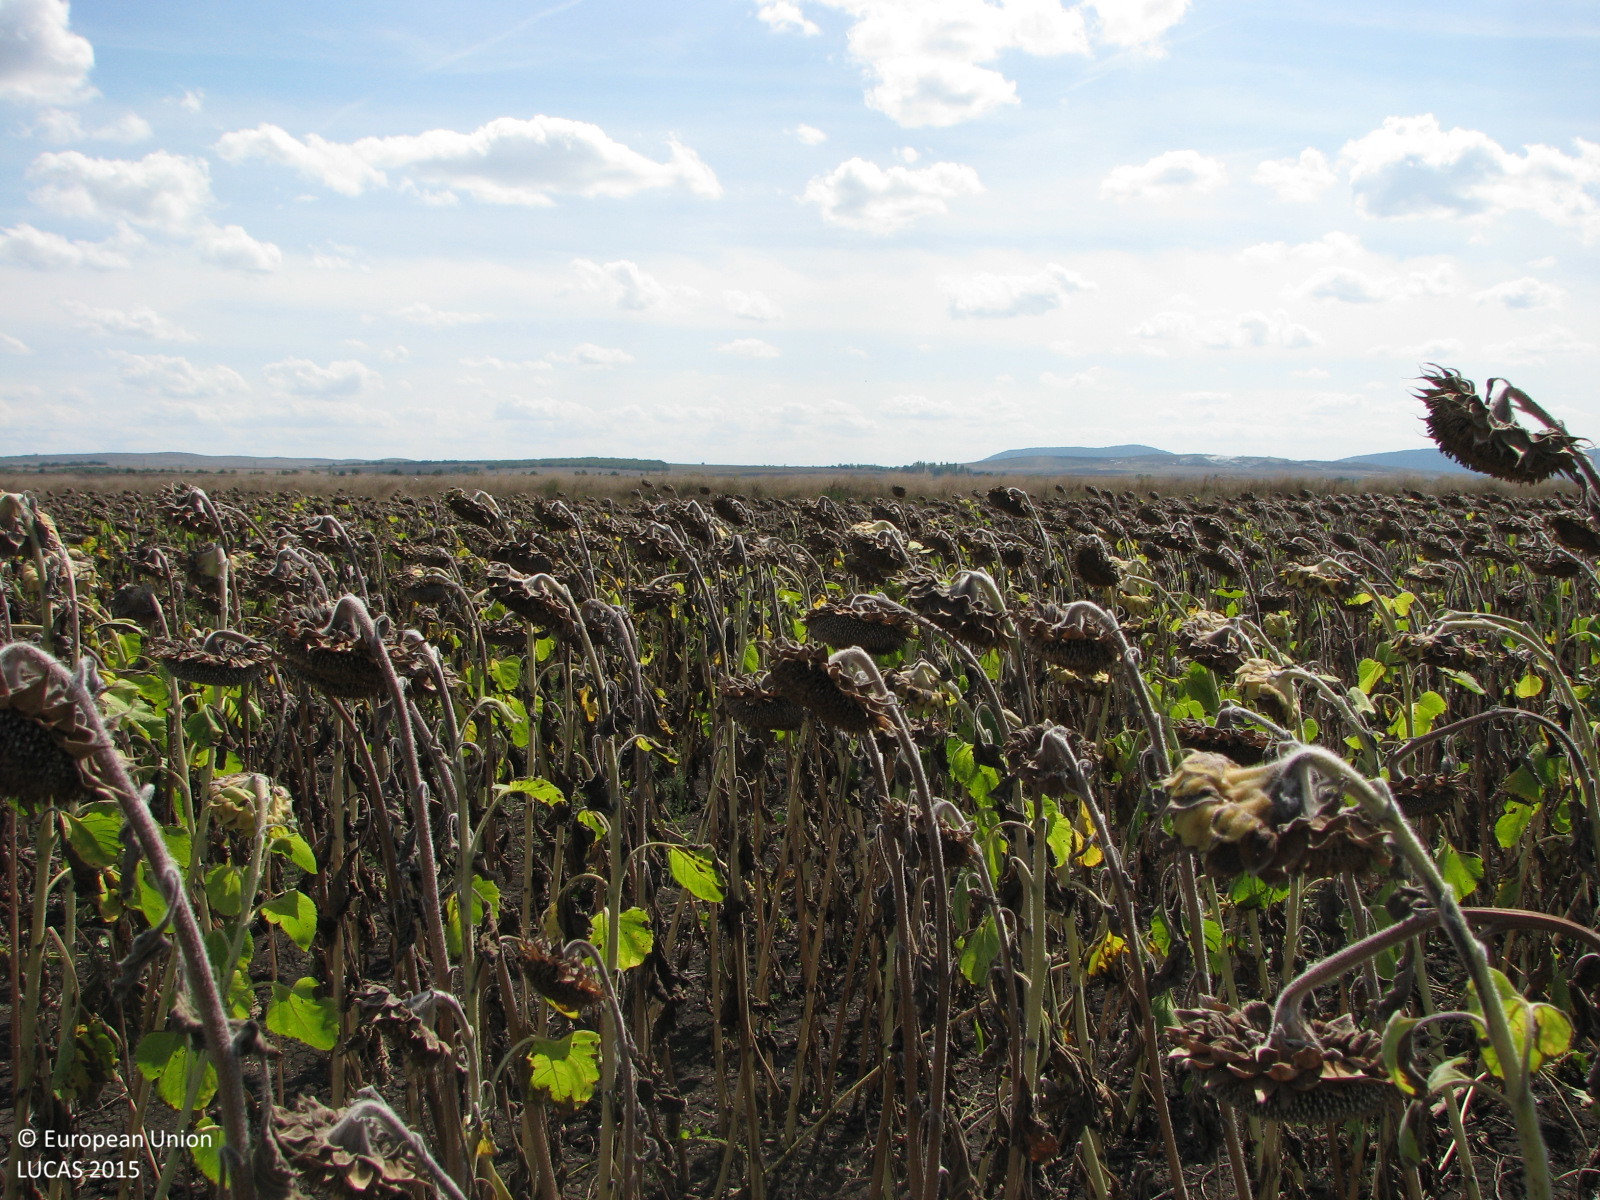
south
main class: Cropland
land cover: Sunflower
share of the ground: > 75 %
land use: Agriculture (excluding fallow land and kitchen gardens)
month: September
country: BG
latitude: 42.5409
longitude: 26.7190
